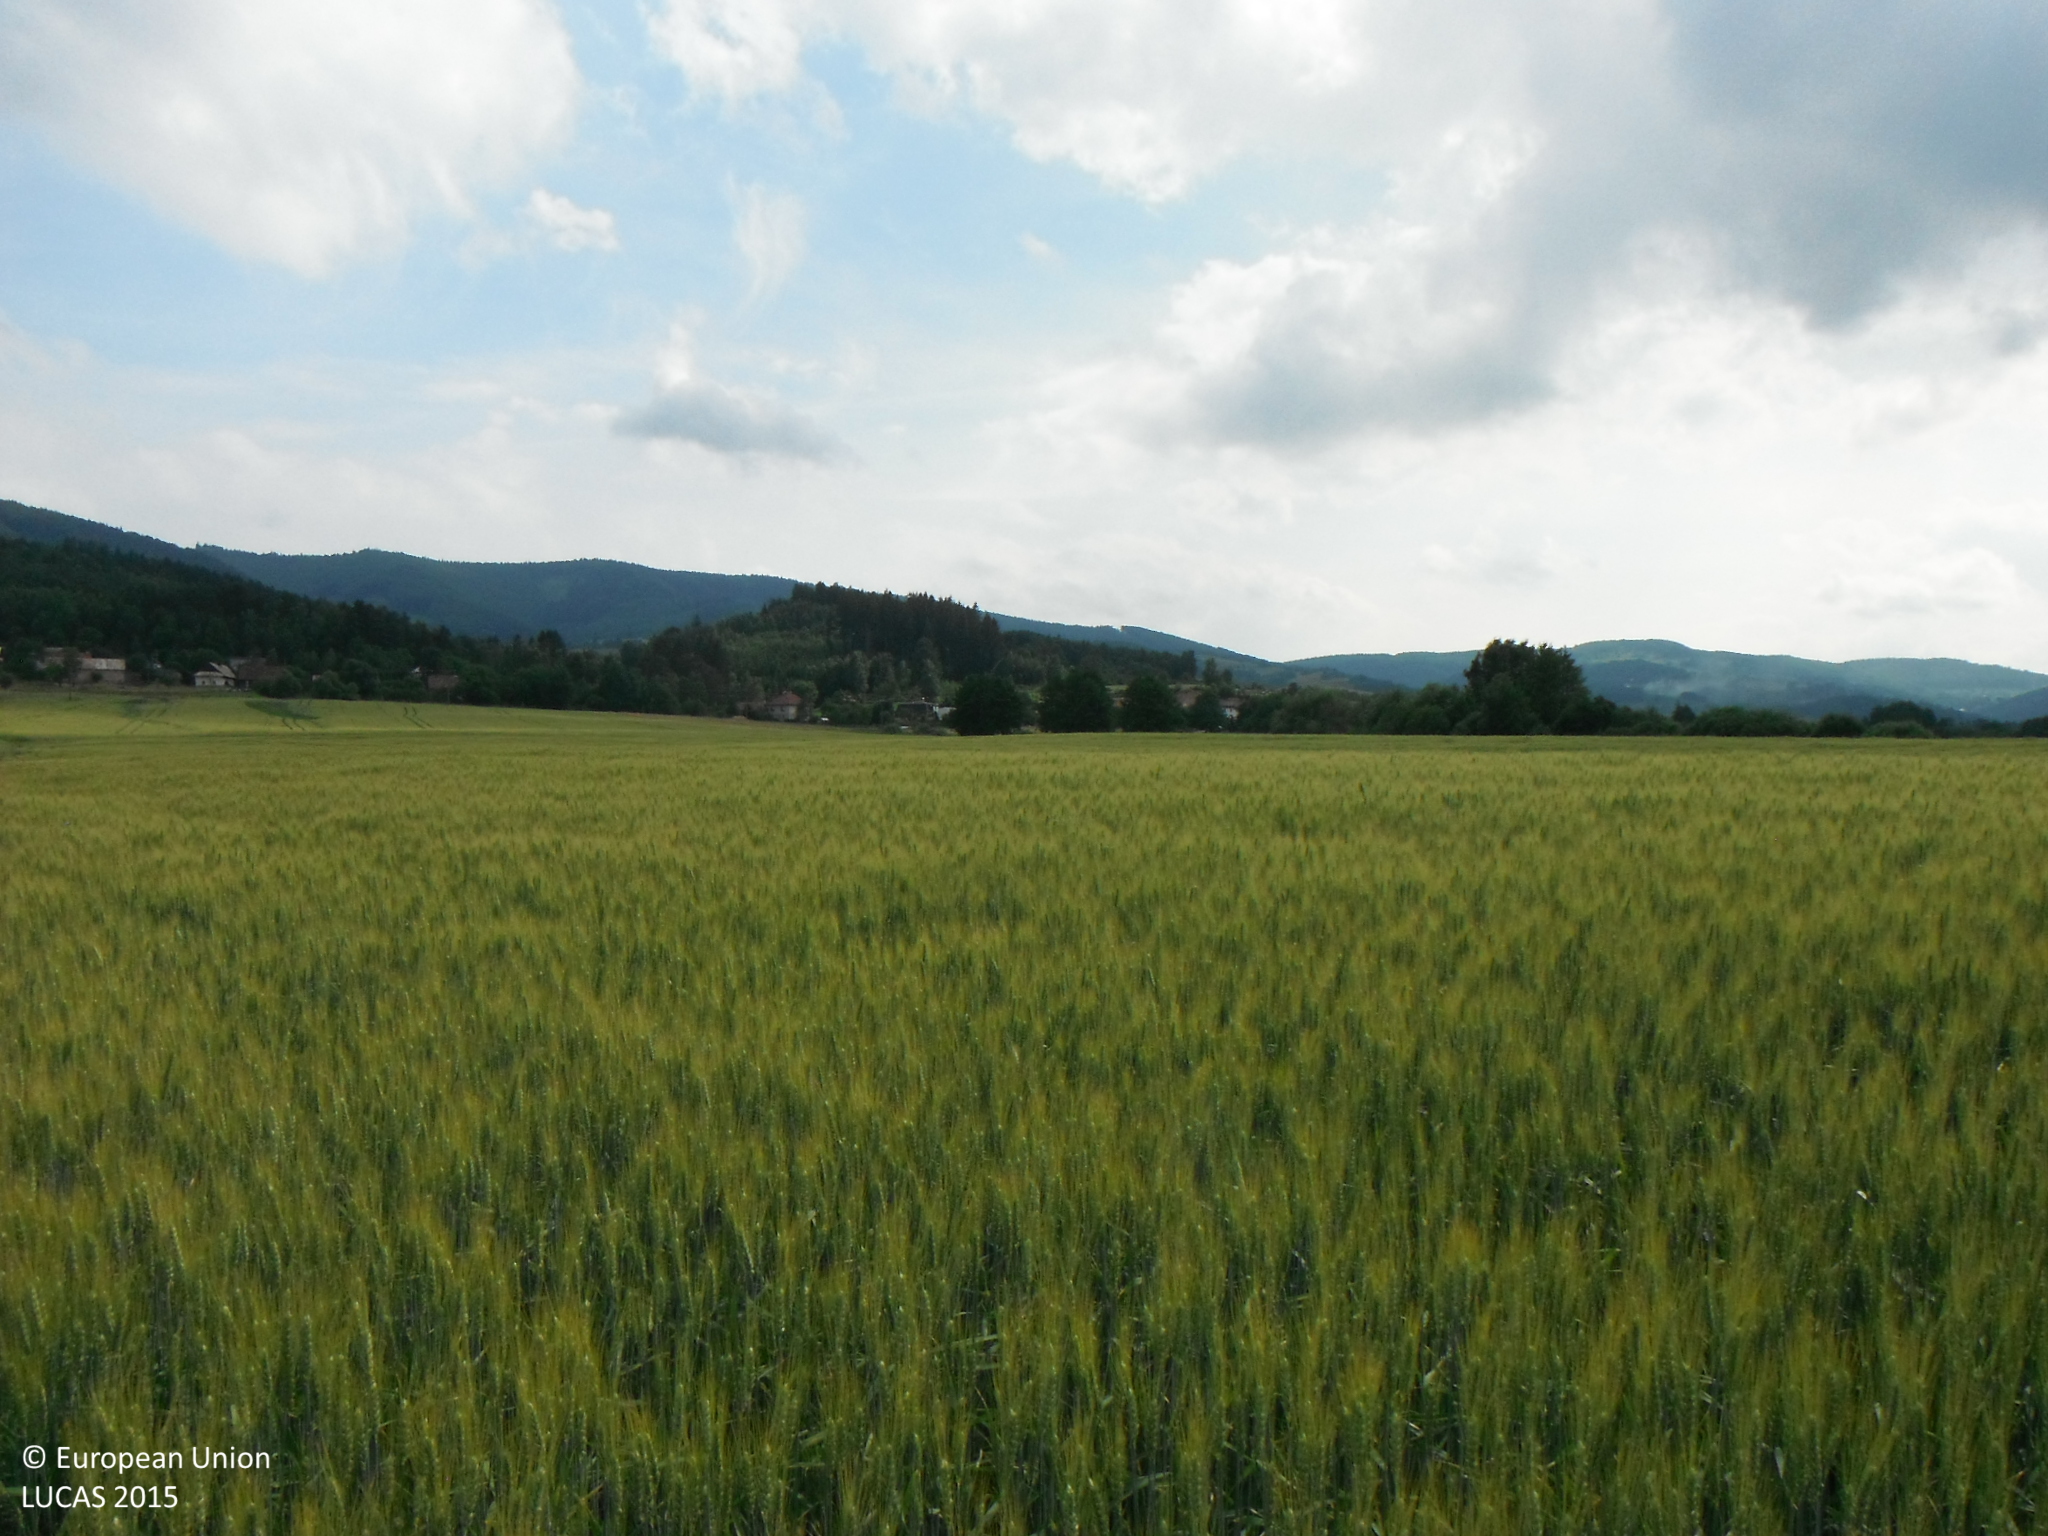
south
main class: Cropland
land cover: Common wheat
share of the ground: > 75 %
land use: Agriculture (excluding fallow land and kitchen gardens)
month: June
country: SK
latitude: 48.5159
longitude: 19.3239
